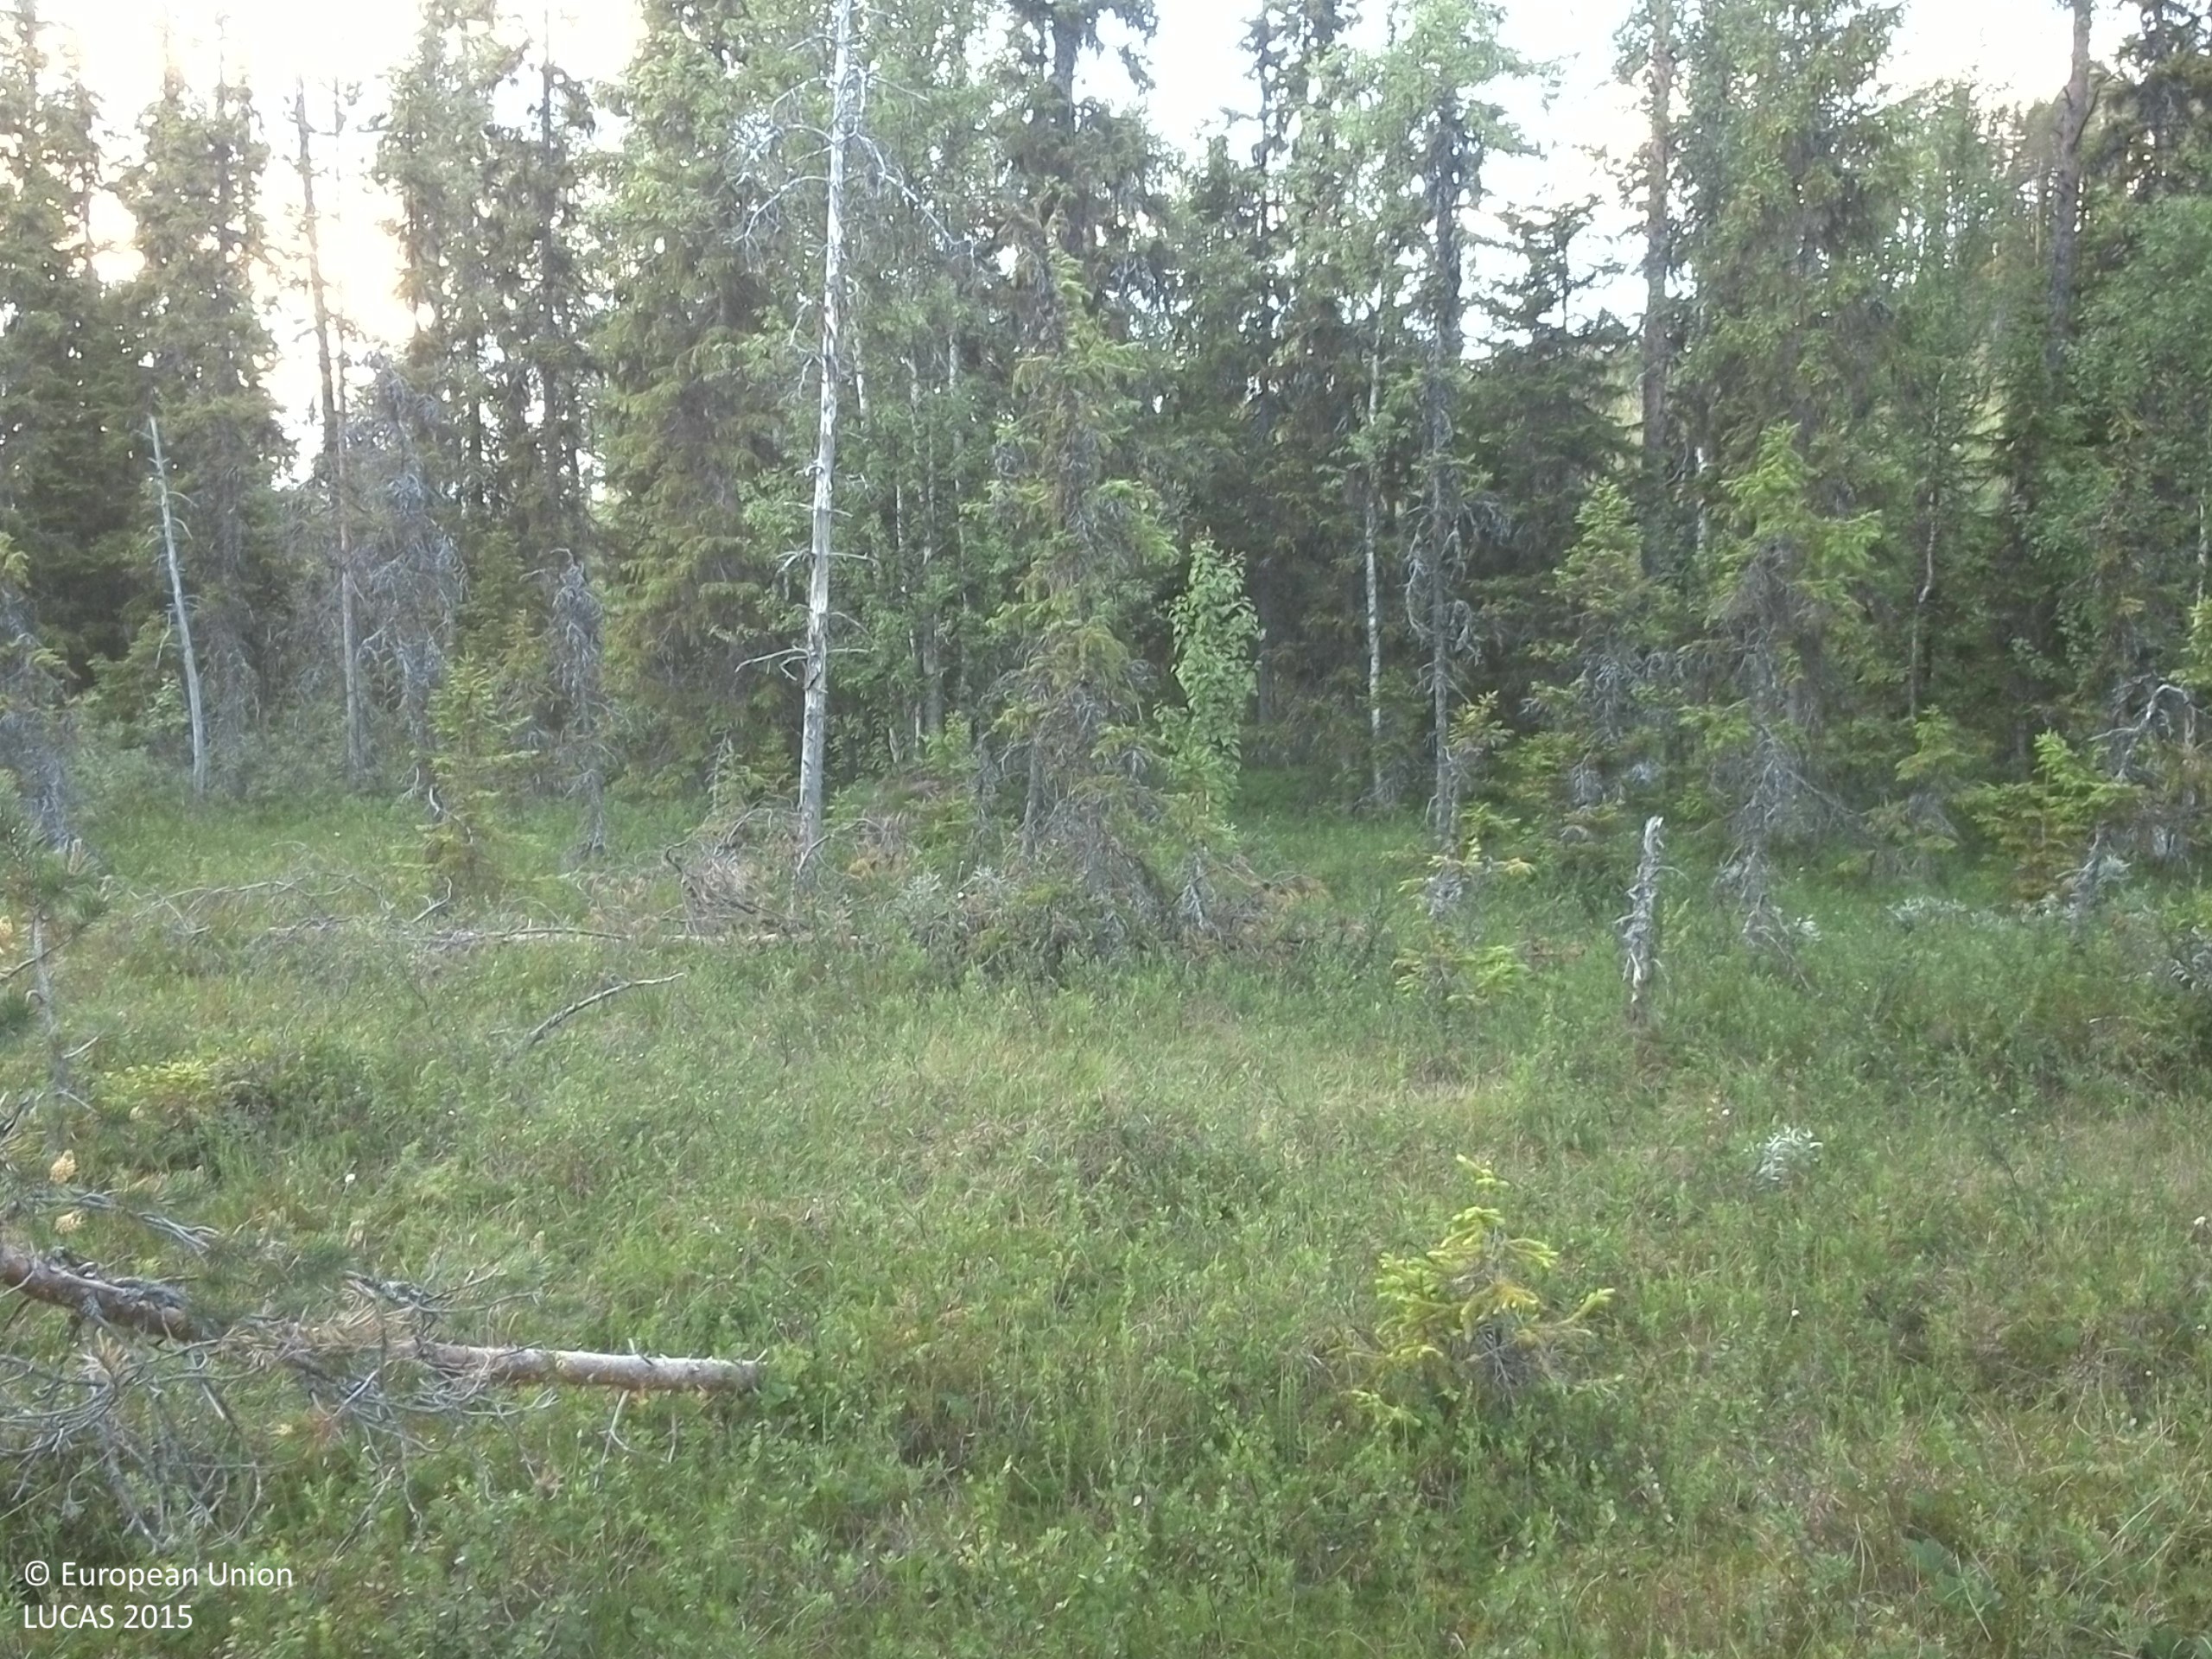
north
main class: Woodland
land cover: Pine dominated coniferous woodland
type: mire and swamp forests
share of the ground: 10 - 25 %
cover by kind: shrubs 55 %, lichens and mosses 20 %, herbaceous plants 15 %, coniferous forest trees 10 %
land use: Semi-natural and natural areas not in use
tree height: > 5 m
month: July
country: SE
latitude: 64.0713
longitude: 16.7960
